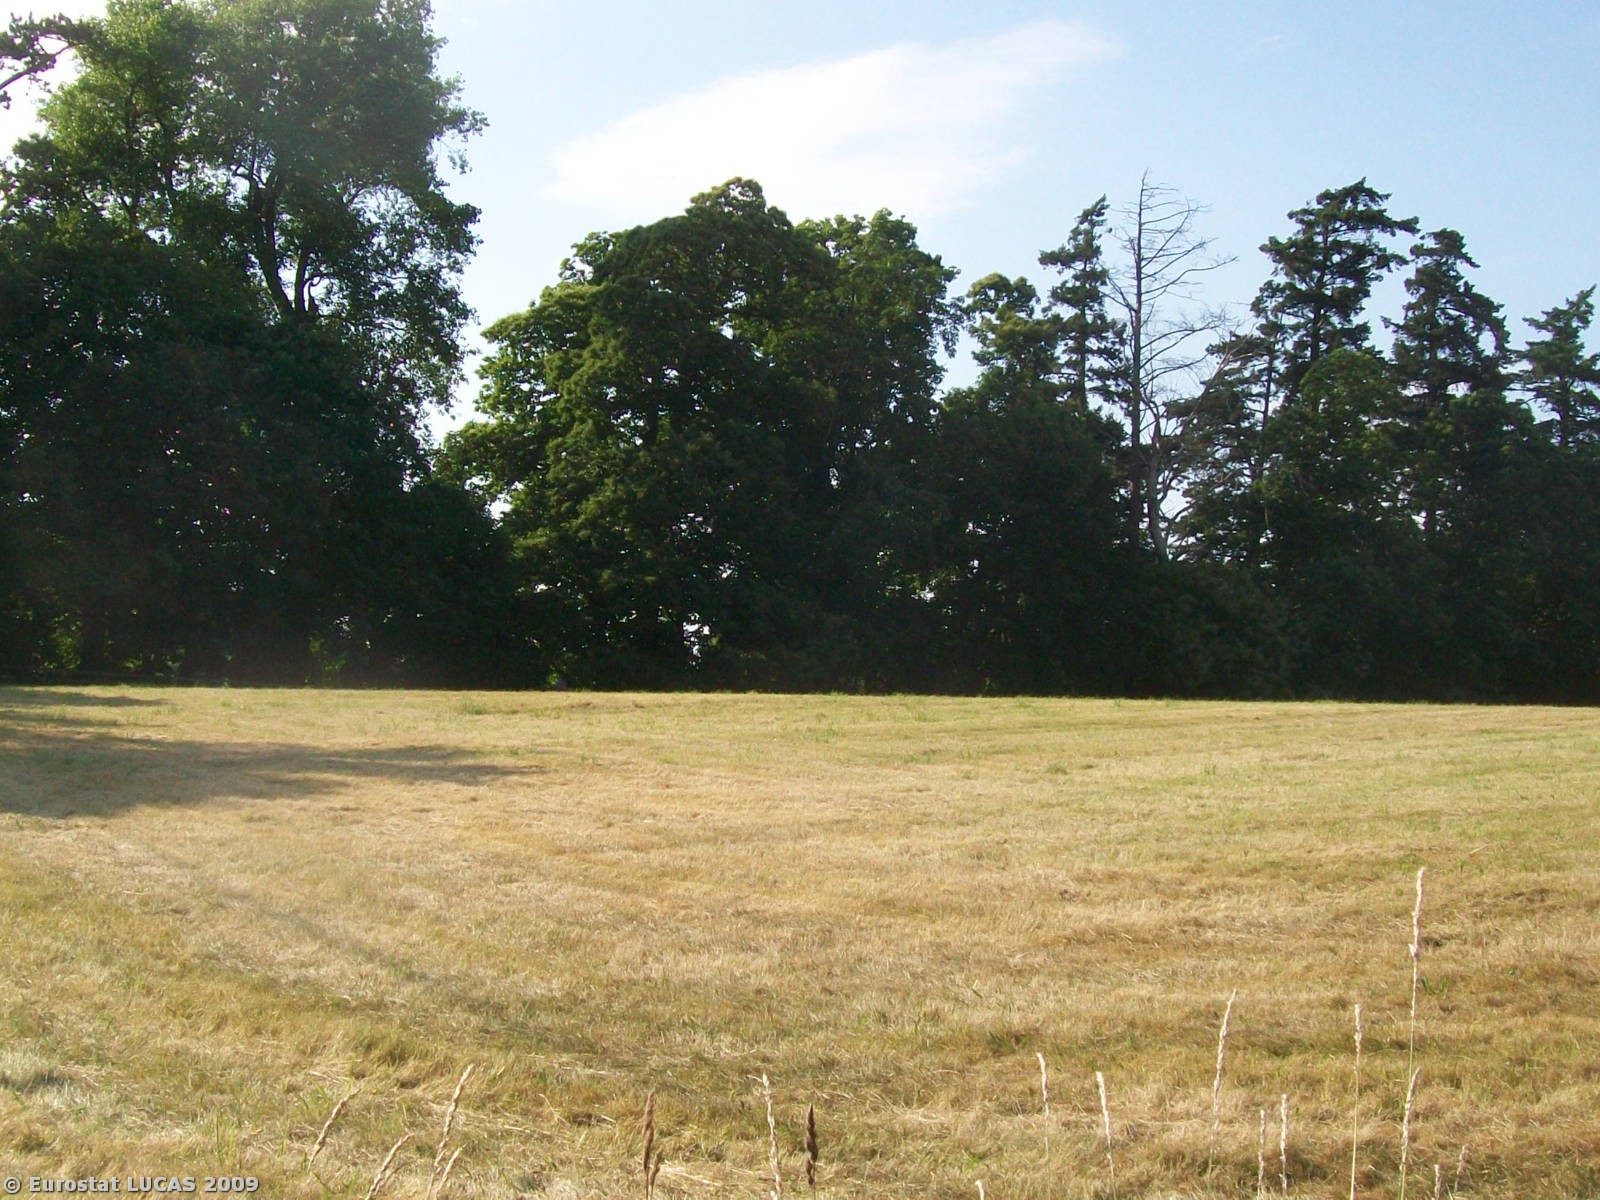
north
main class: Grassland
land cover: Grassland without tree/shrub cover
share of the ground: > 75 %
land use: Agriculture (excluding fallow land and kitchen gardens)
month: June
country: GB
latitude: 50.9567
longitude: -0.6173
